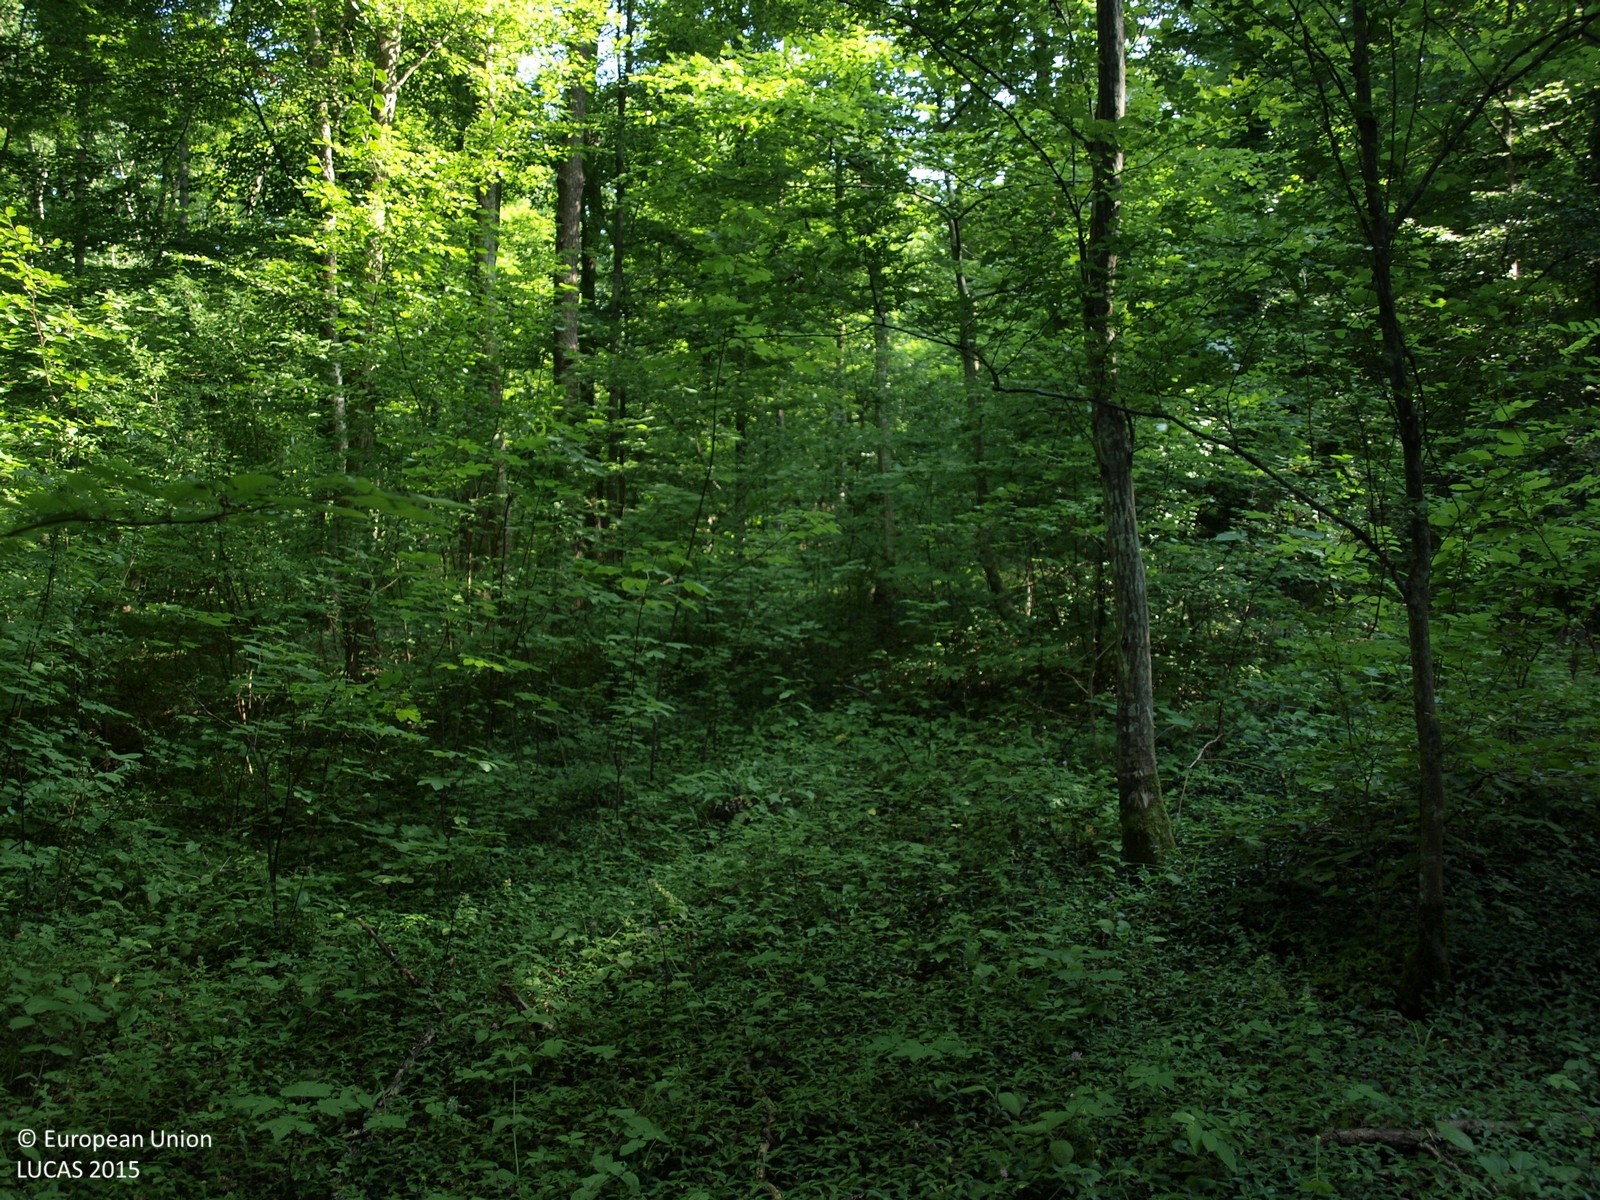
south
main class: Woodland
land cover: Broadleaved woodland
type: beech forest
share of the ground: > 75 %
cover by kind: broadleaved forest trees 100 %
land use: Forestry
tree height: > 5 m
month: July
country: HR
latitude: 46.1291
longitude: 15.9912
